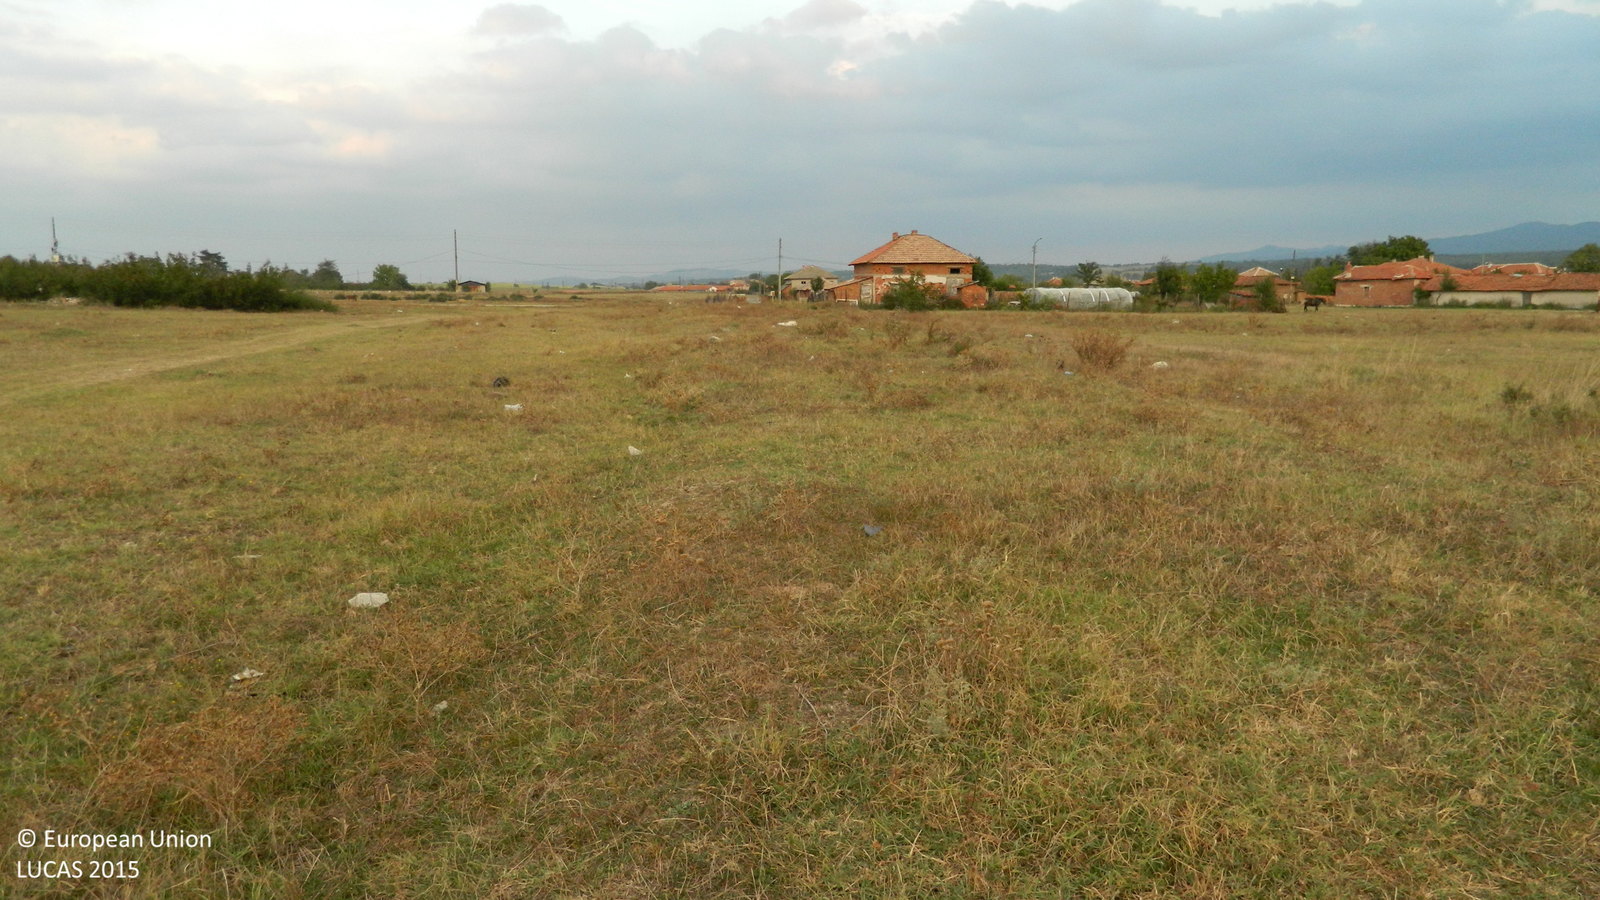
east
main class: Grassland
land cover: Grassland without tree/shrub cover
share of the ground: > 75 %
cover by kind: herbaceous plants 100 %
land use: Agriculture (excluding fallow land and kitchen gardens)
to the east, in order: Grassland without tree/shrub cover; Tracks; Grassland without tree/shrub cover; Paved roads, cycling and walking lanes; Grassland without tree/shrub cover; Electric lines; Grassland without tree/shrub cover; Tracks; Fences; Grassland without tree/shrub cover; Fences; Grassland without tree/shrub cover
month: September
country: BG
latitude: 41.8127
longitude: 25.7762
